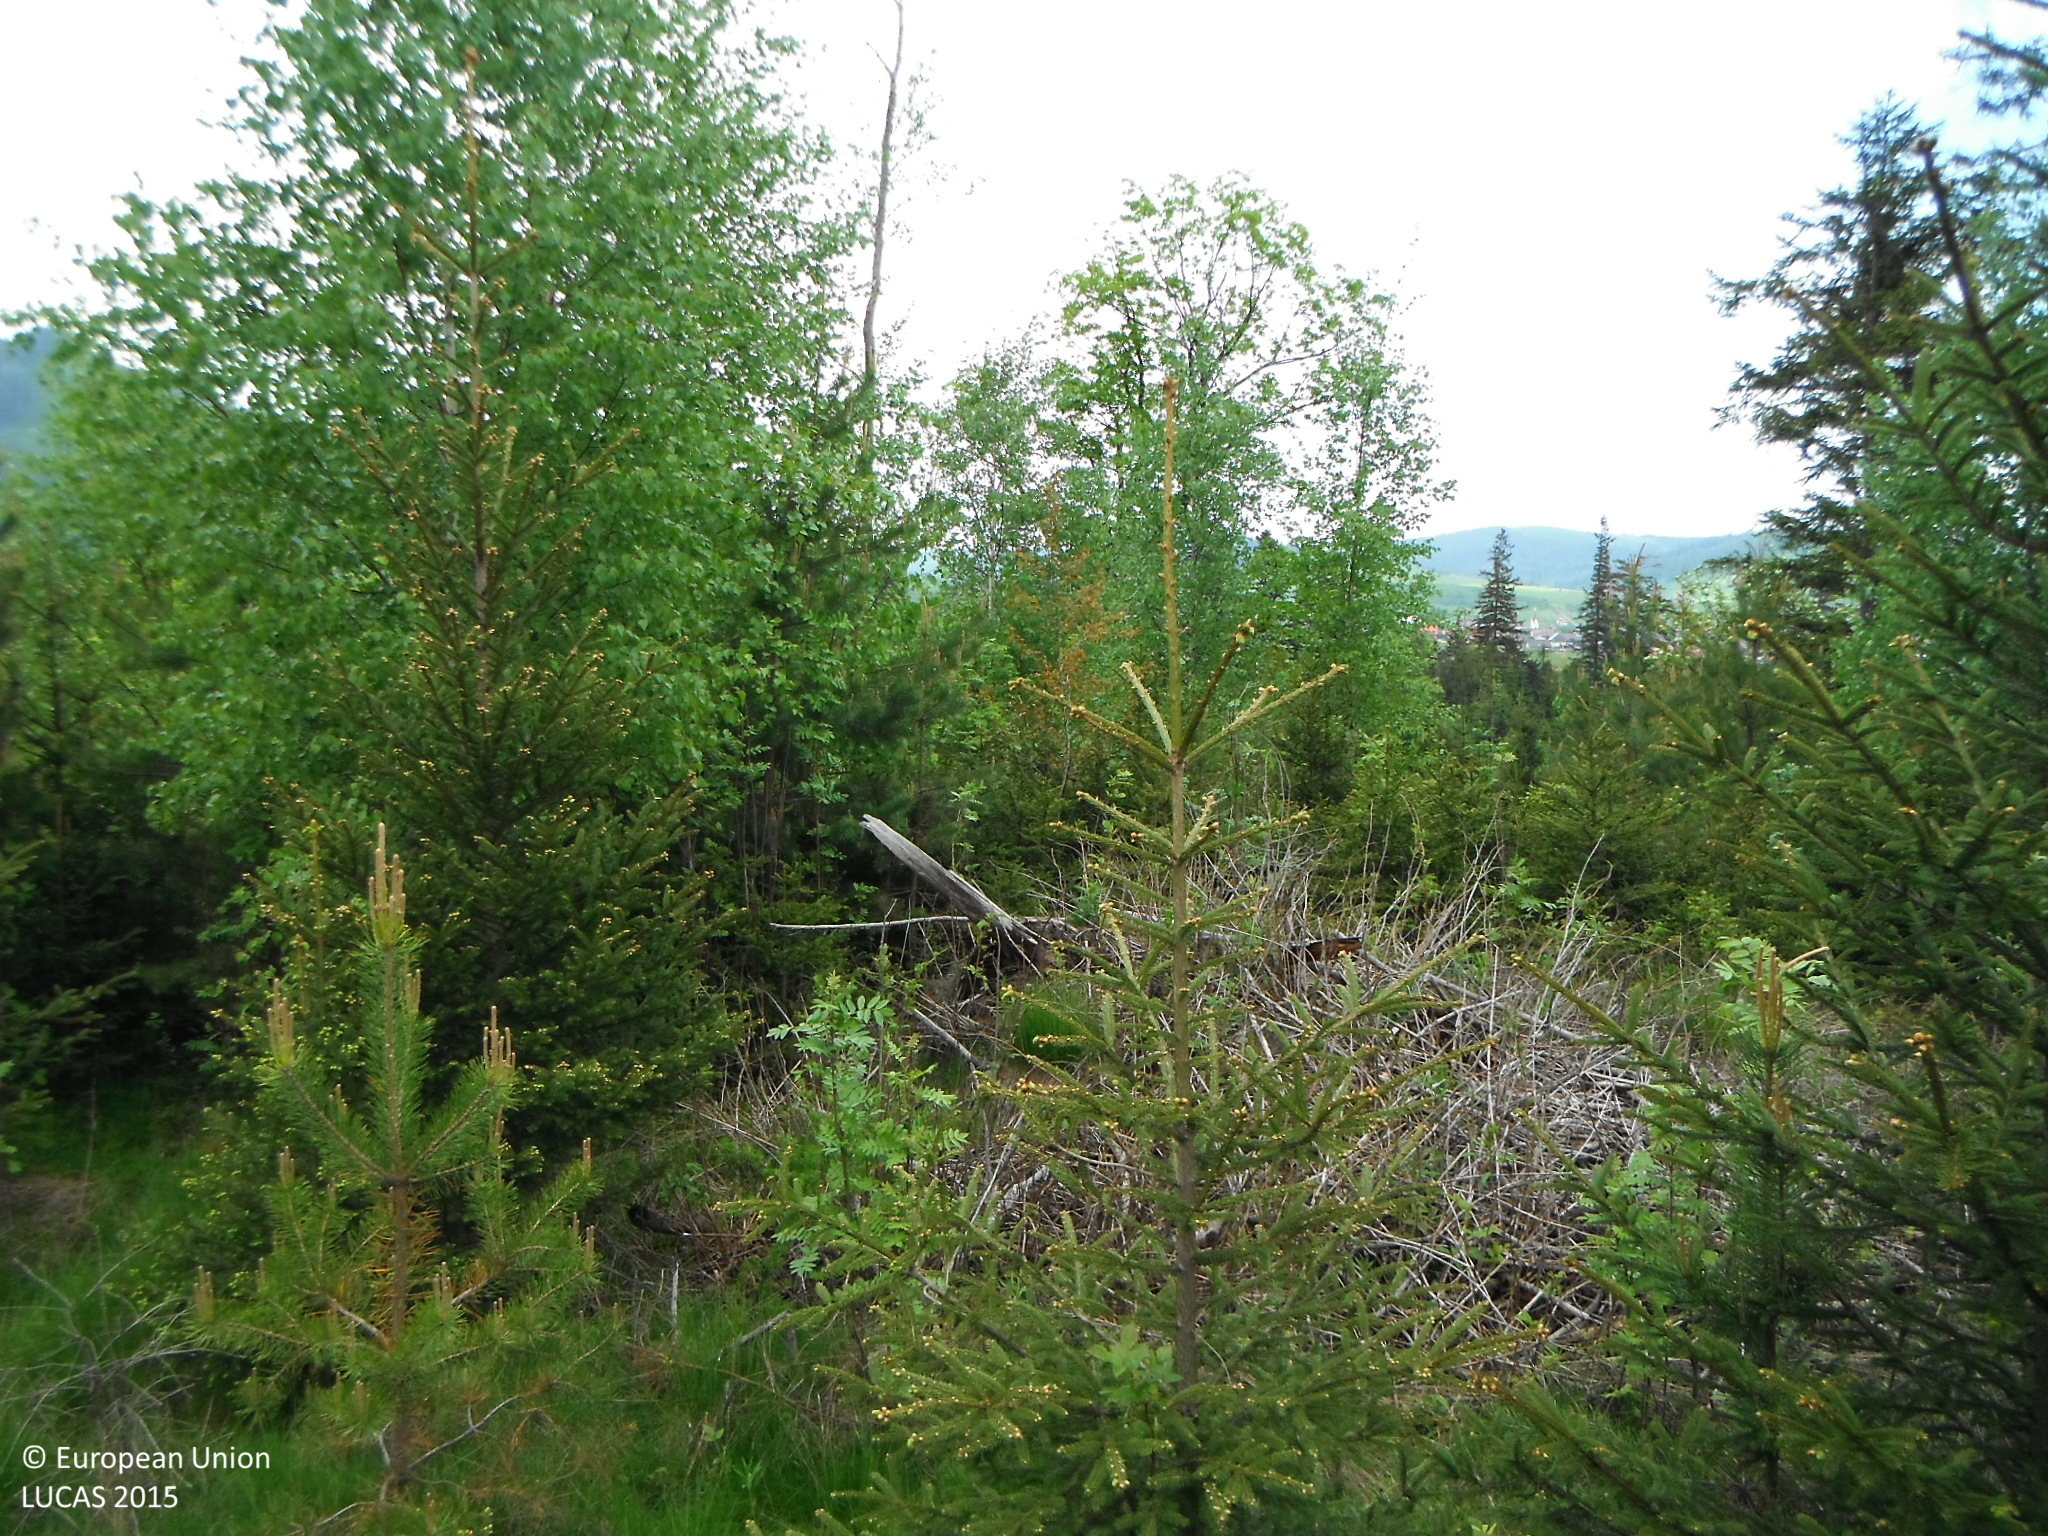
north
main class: Woodland
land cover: Pine dominated mixed woodland
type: alpine coniferous forest
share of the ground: > 75 %
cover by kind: coniferous forest trees 50 %, broadleaved forest trees 25 %, herbaceous plants 15 %, lichens and mosses 5 %, consolidated bare surface 5 %
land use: Forestry
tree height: < 5 m
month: May
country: SK
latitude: 49.2227
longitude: 20.3462
